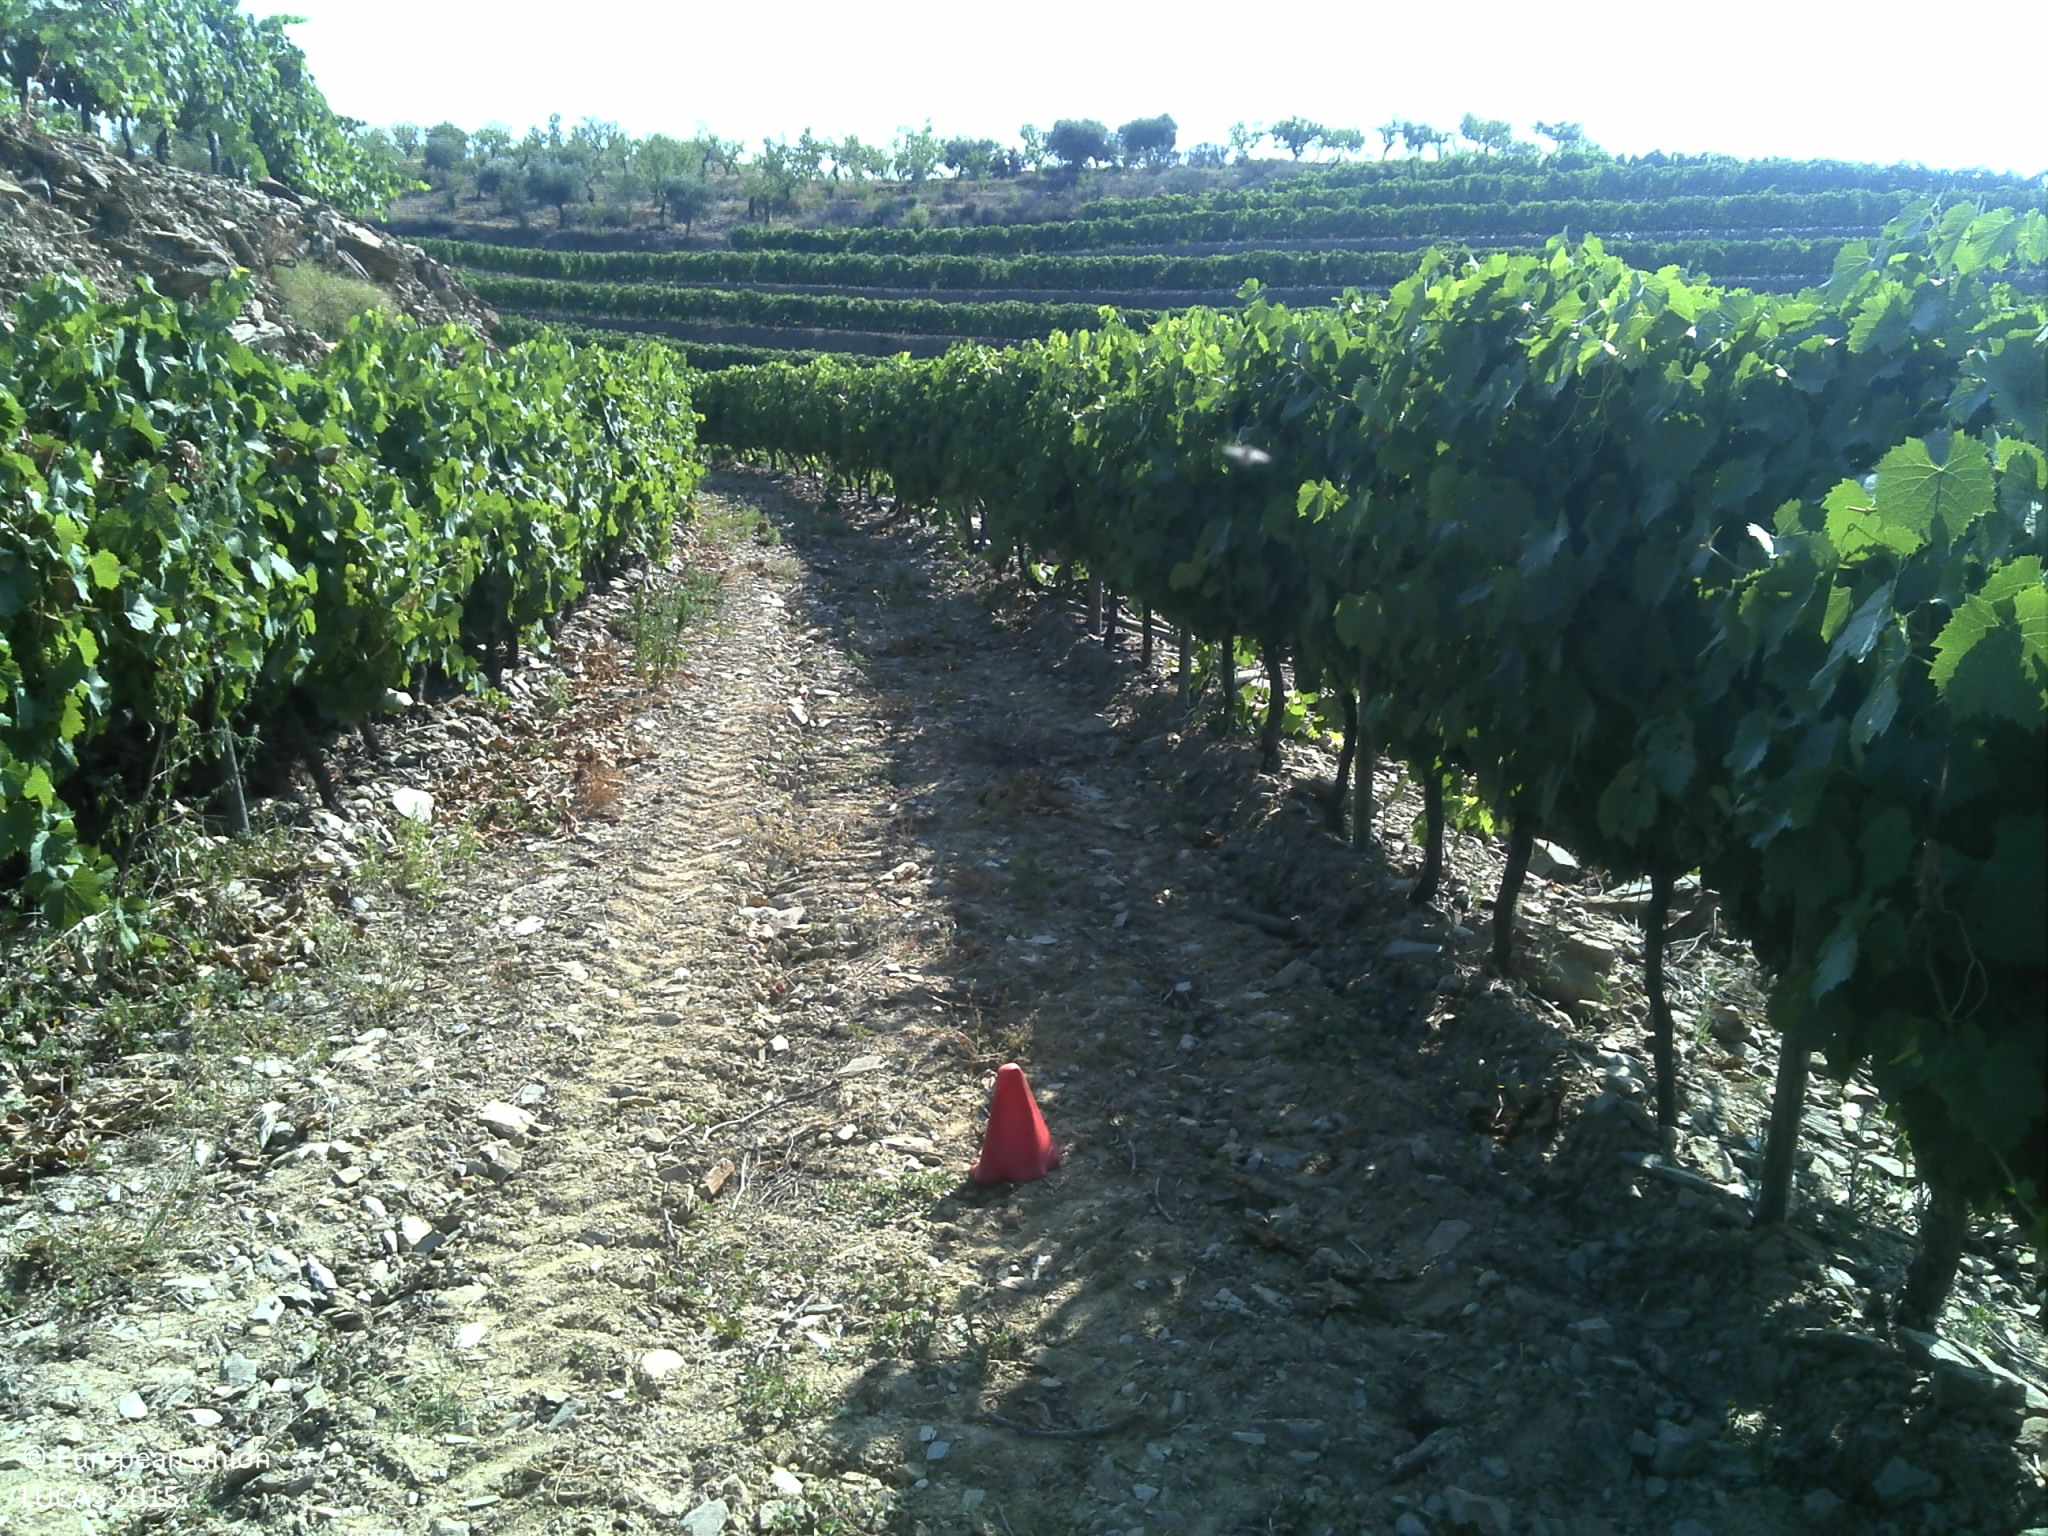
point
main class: Cropland
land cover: Vineyards
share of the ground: 25 - 50 %
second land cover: Grassland without tree/shrub cover
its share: 50 - 75 %
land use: Agriculture (excluding fallow land and kitchen gardens)
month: June
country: PT
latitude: 41.1909
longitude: -7.0781
